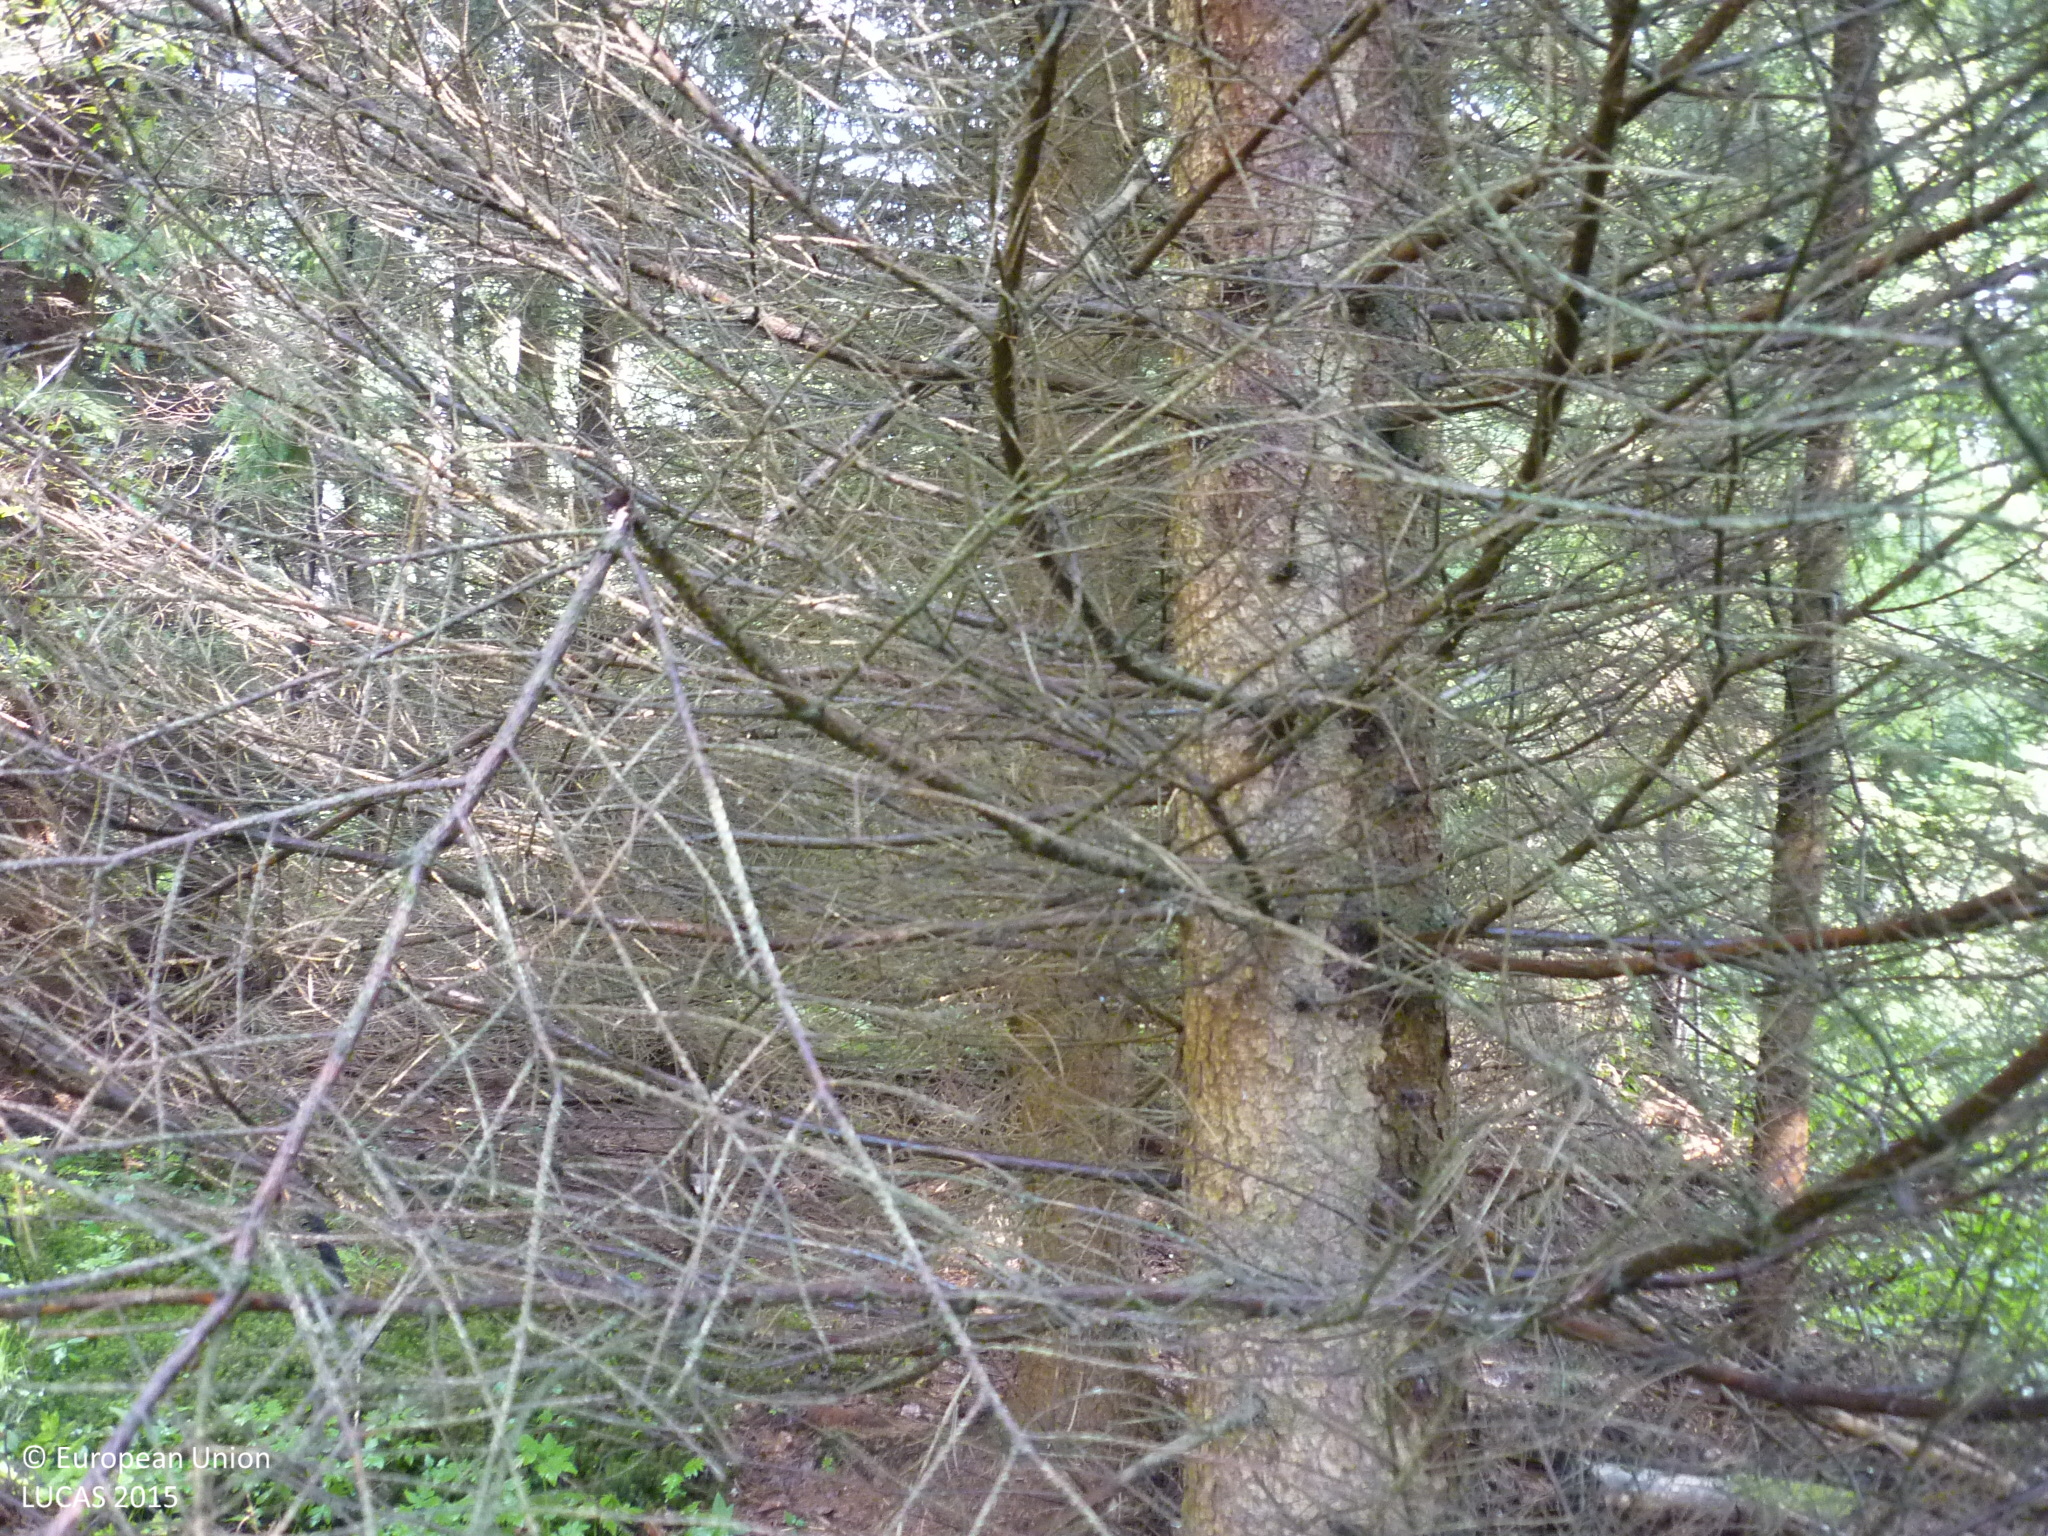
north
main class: Woodland
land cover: Spruce dominated mixed woodland
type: hemiboreal forest and nemoral coniferous forest and mixed broadleaved-coniferous forest
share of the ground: > 75 %
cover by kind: coniferous forest trees 75 %, broadleaved forest trees 25 %
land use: Forestry
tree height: > 5 m
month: September
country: AT
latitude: 49.0093
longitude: 15.0470
